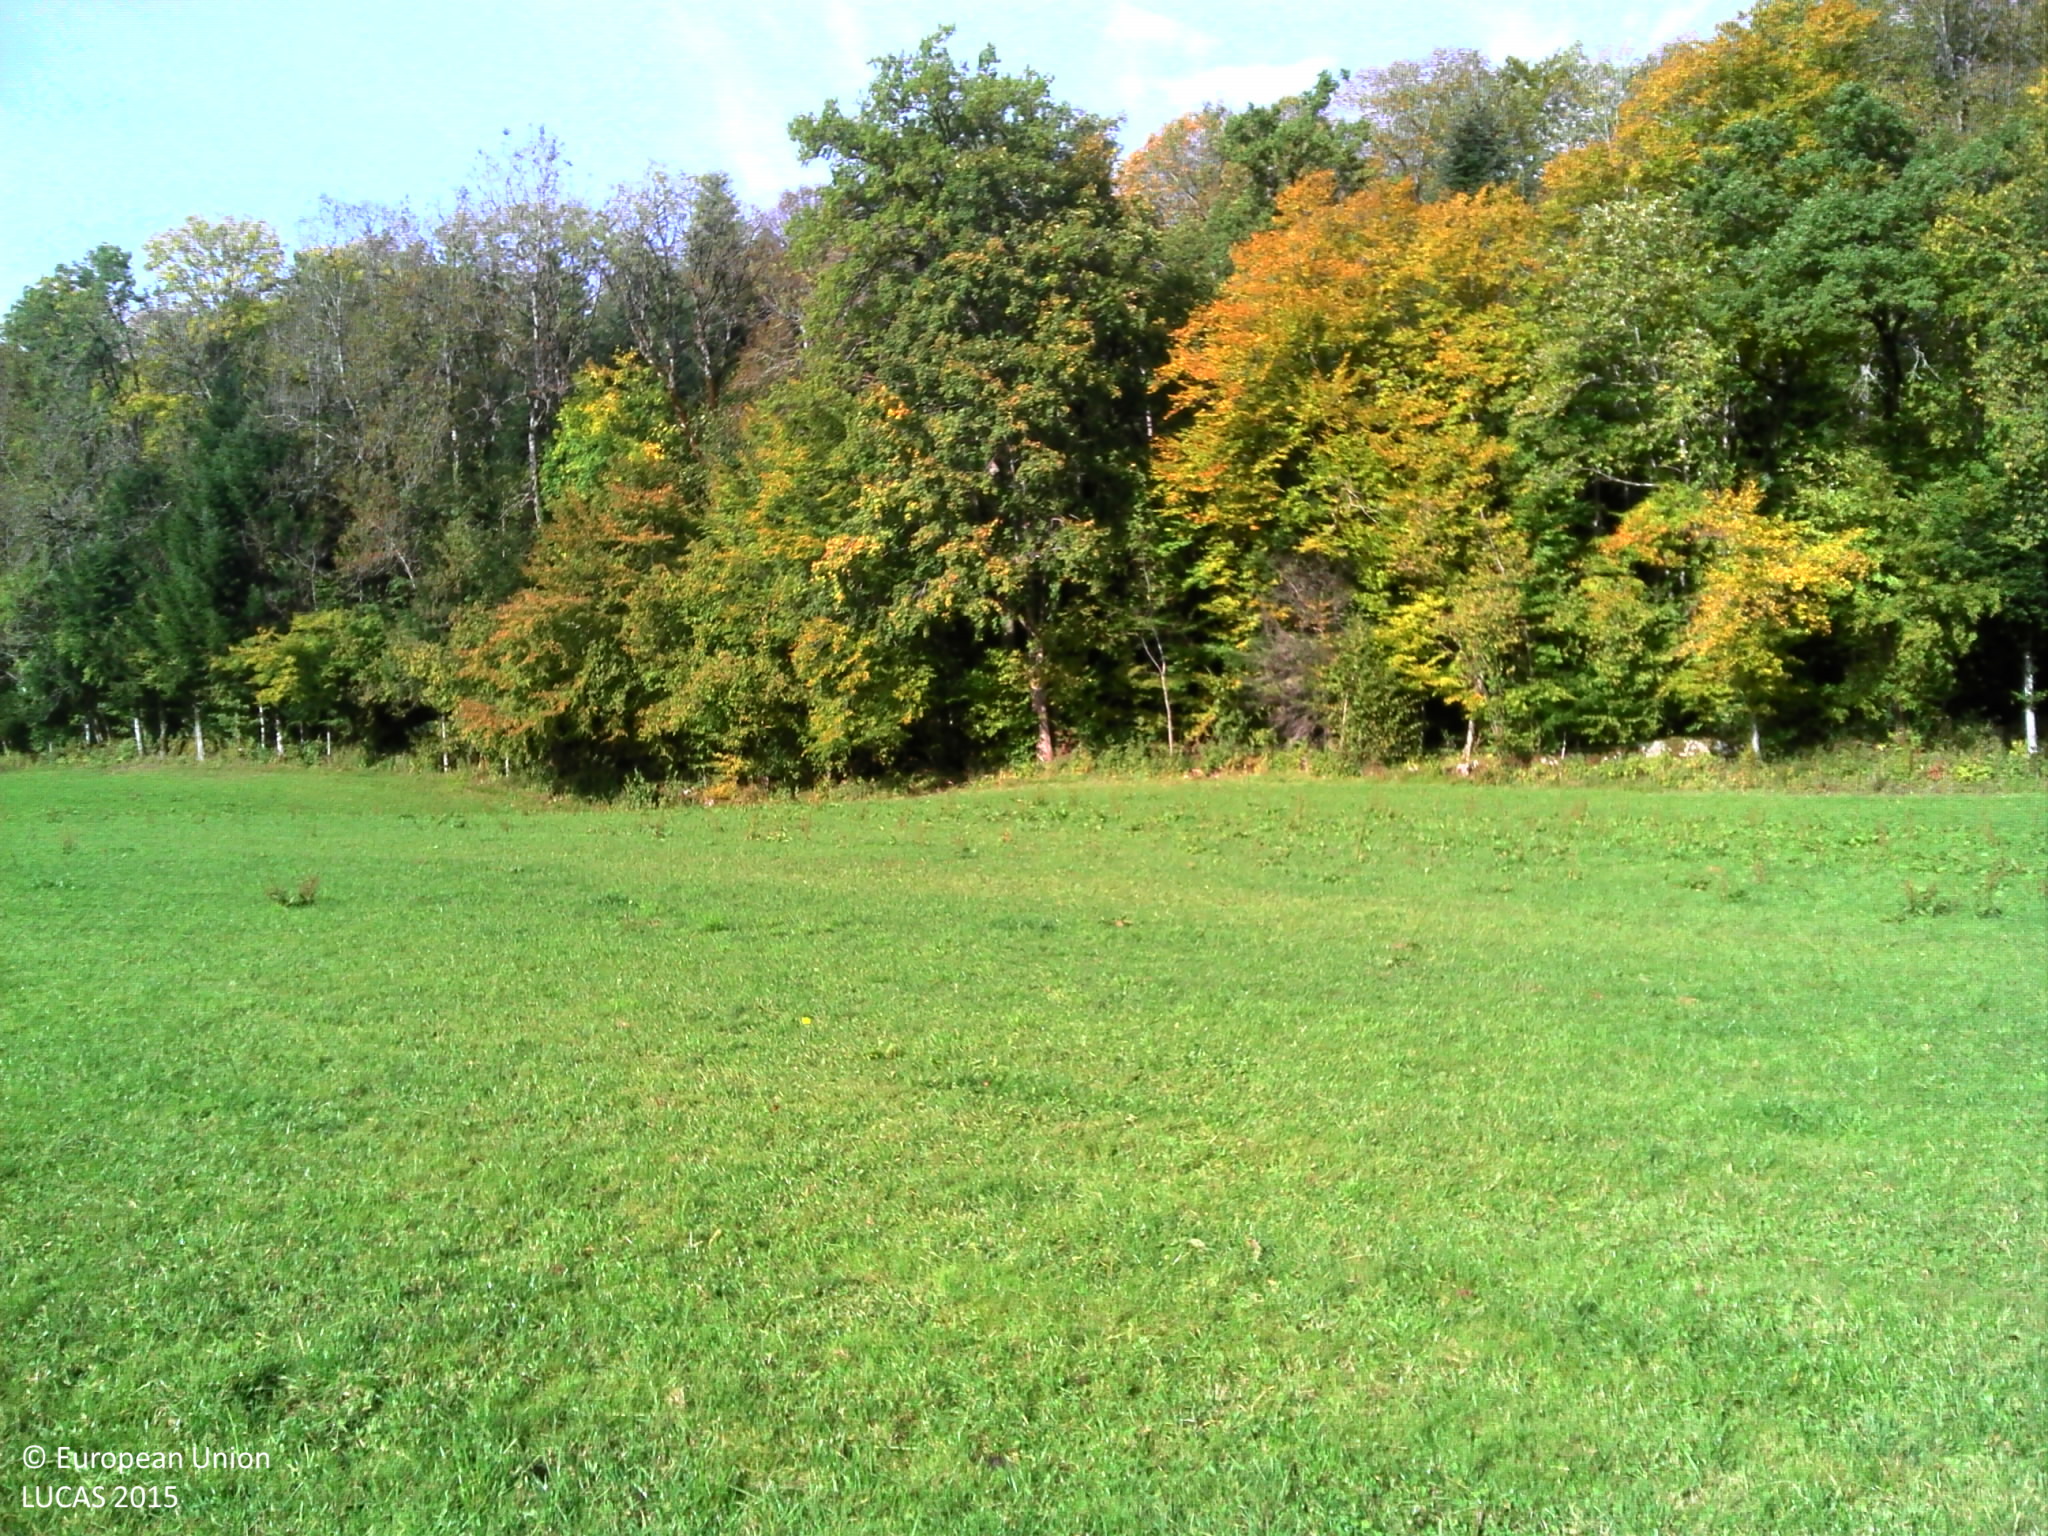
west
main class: Grassland
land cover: Grassland without tree/shrub cover
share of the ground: > 75 %
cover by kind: herbaceous plants 100 %
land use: Agriculture (excluding fallow land and kitchen gardens)
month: October
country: FR
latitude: 47.0625
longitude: 6.3024
